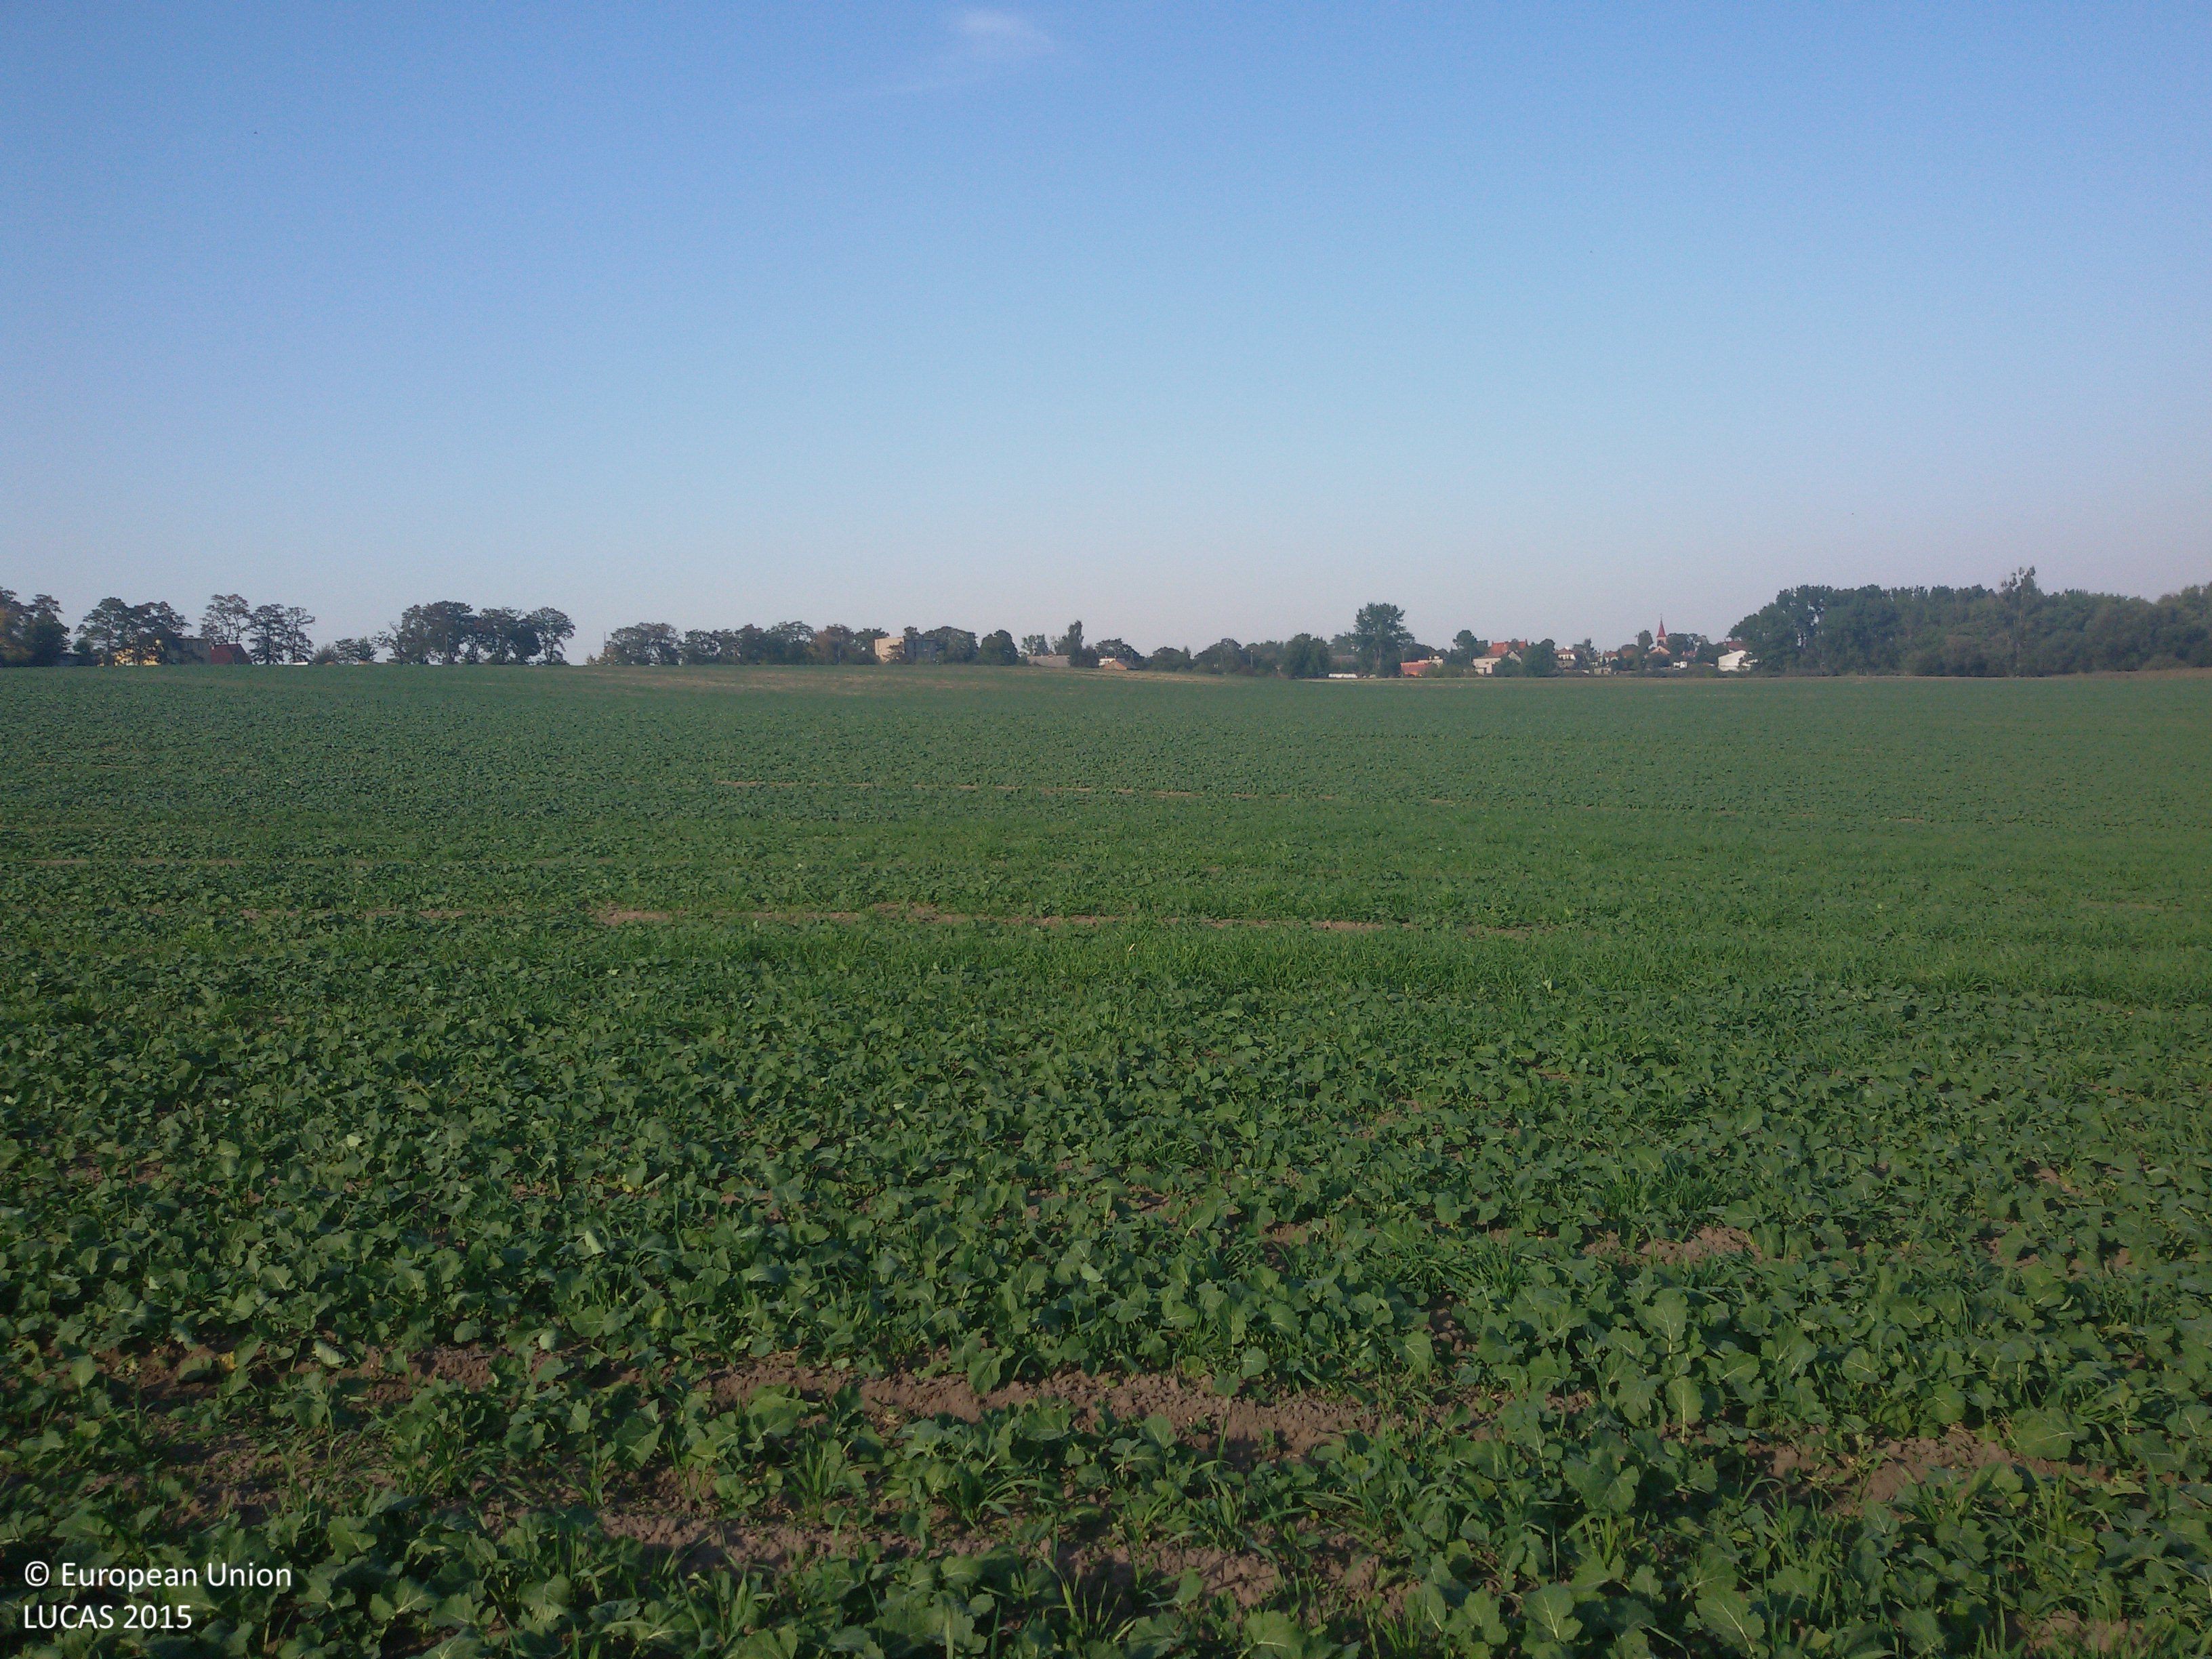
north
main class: Cropland
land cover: Rape and turnip rape
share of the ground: > 75 %
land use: Agriculture (excluding fallow land and kitchen gardens)
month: October
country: PL
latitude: 52.6108
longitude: 18.0347
